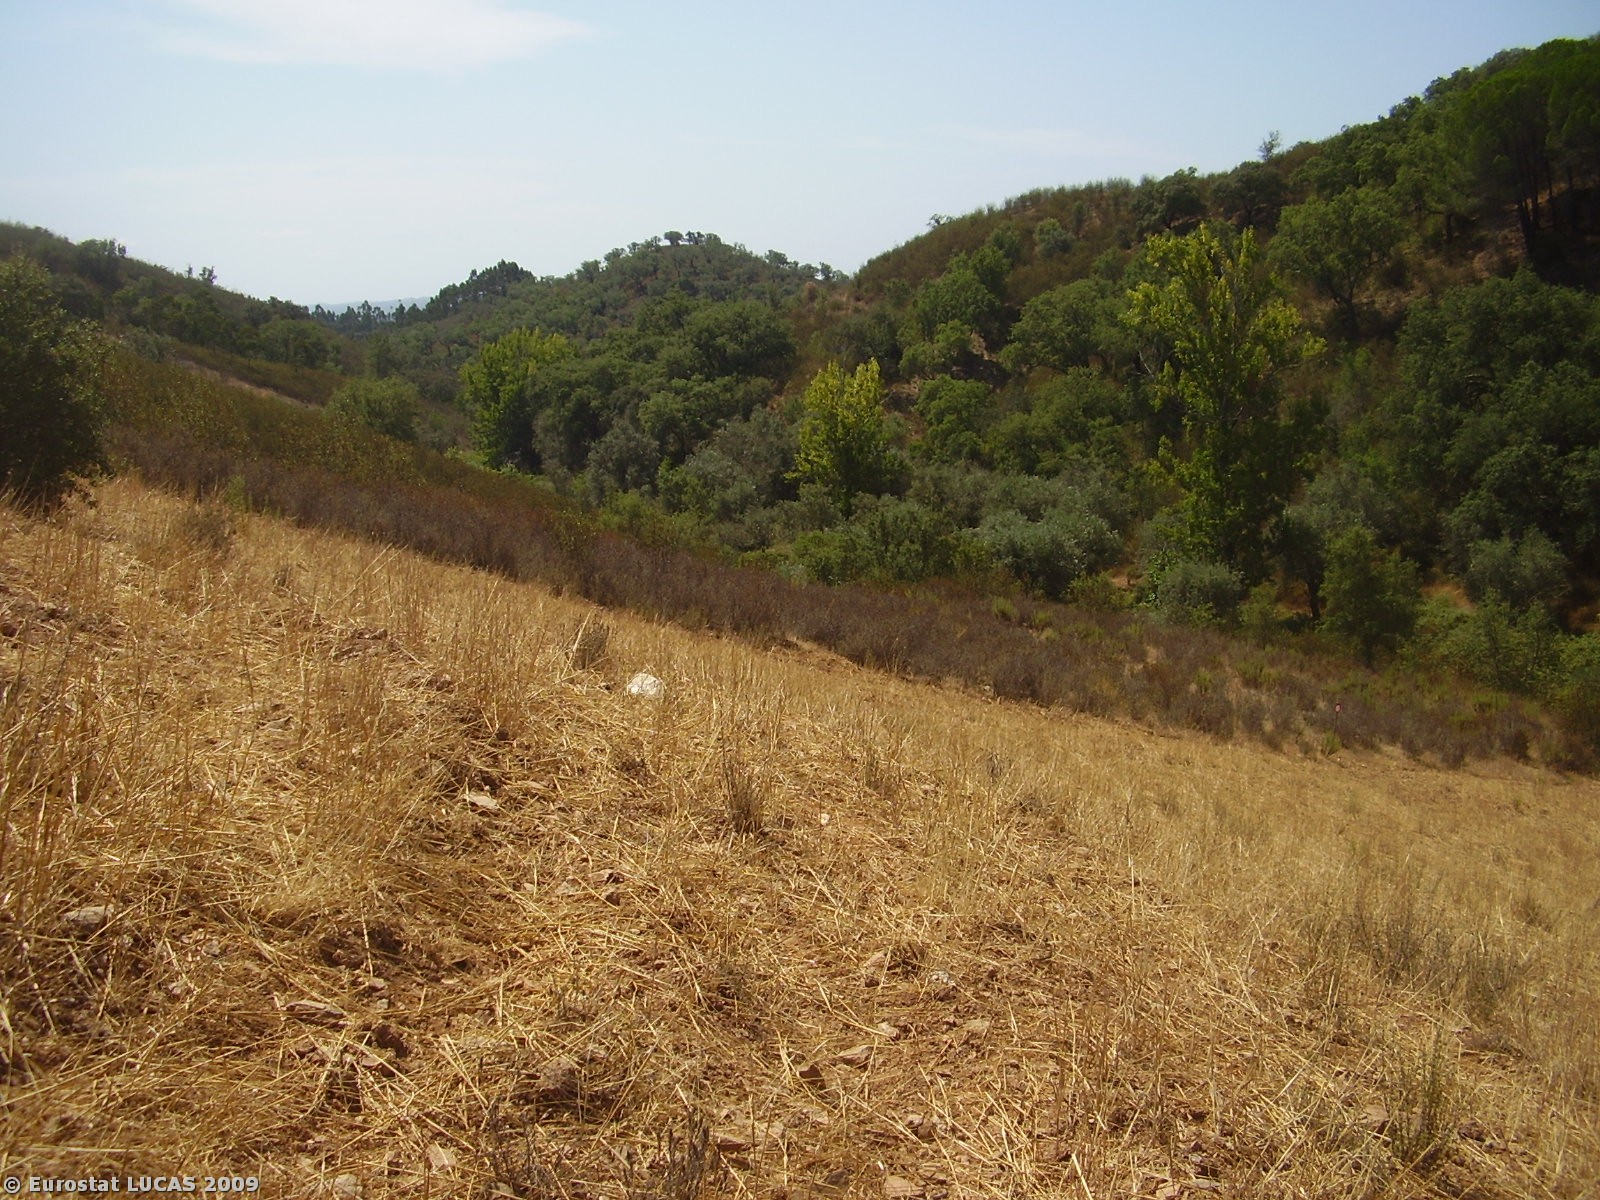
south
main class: Cropland
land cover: Oats
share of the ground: > 75 %
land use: Agriculture (excluding fallow land and kitchen gardens)
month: August
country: PT
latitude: 37.5953
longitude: -8.3447
